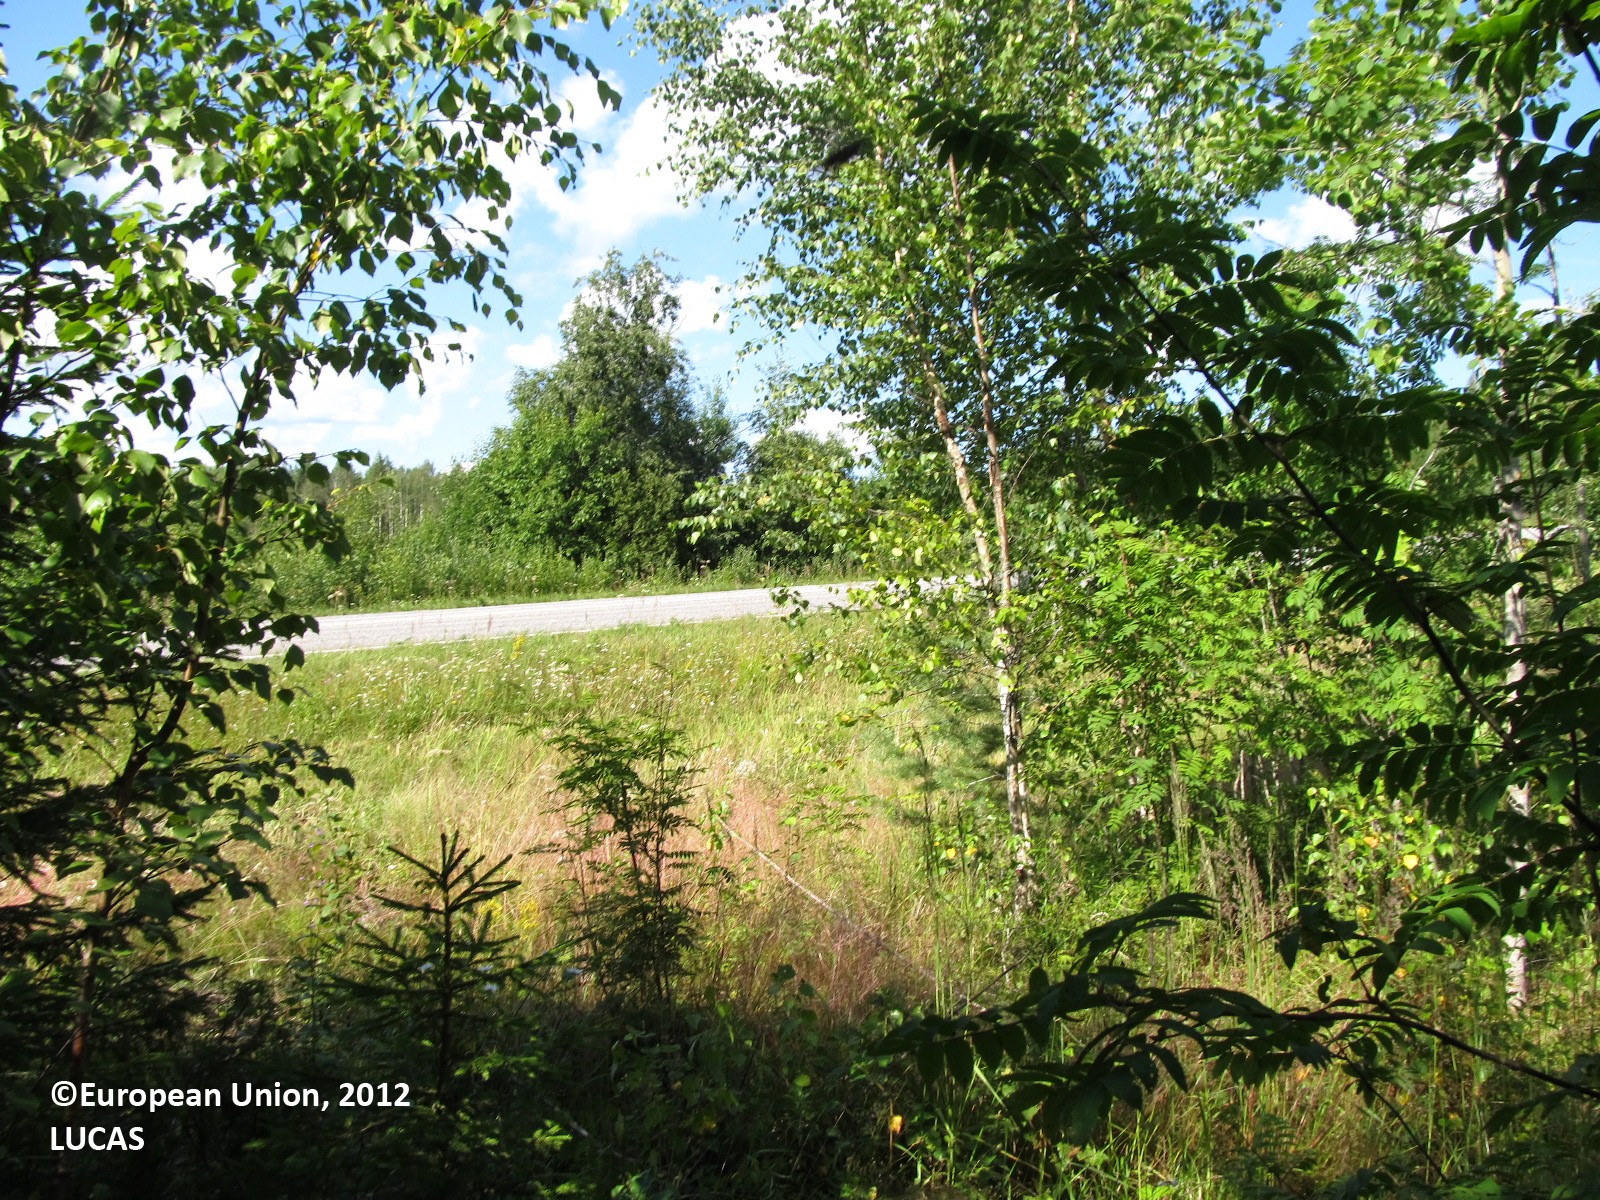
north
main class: Woodland
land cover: Spruce dominated mixed woodland
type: boreal forest
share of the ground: > 75 %
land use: Forestry
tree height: > 5 m
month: July
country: FI
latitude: 61.9427
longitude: 28.1277
